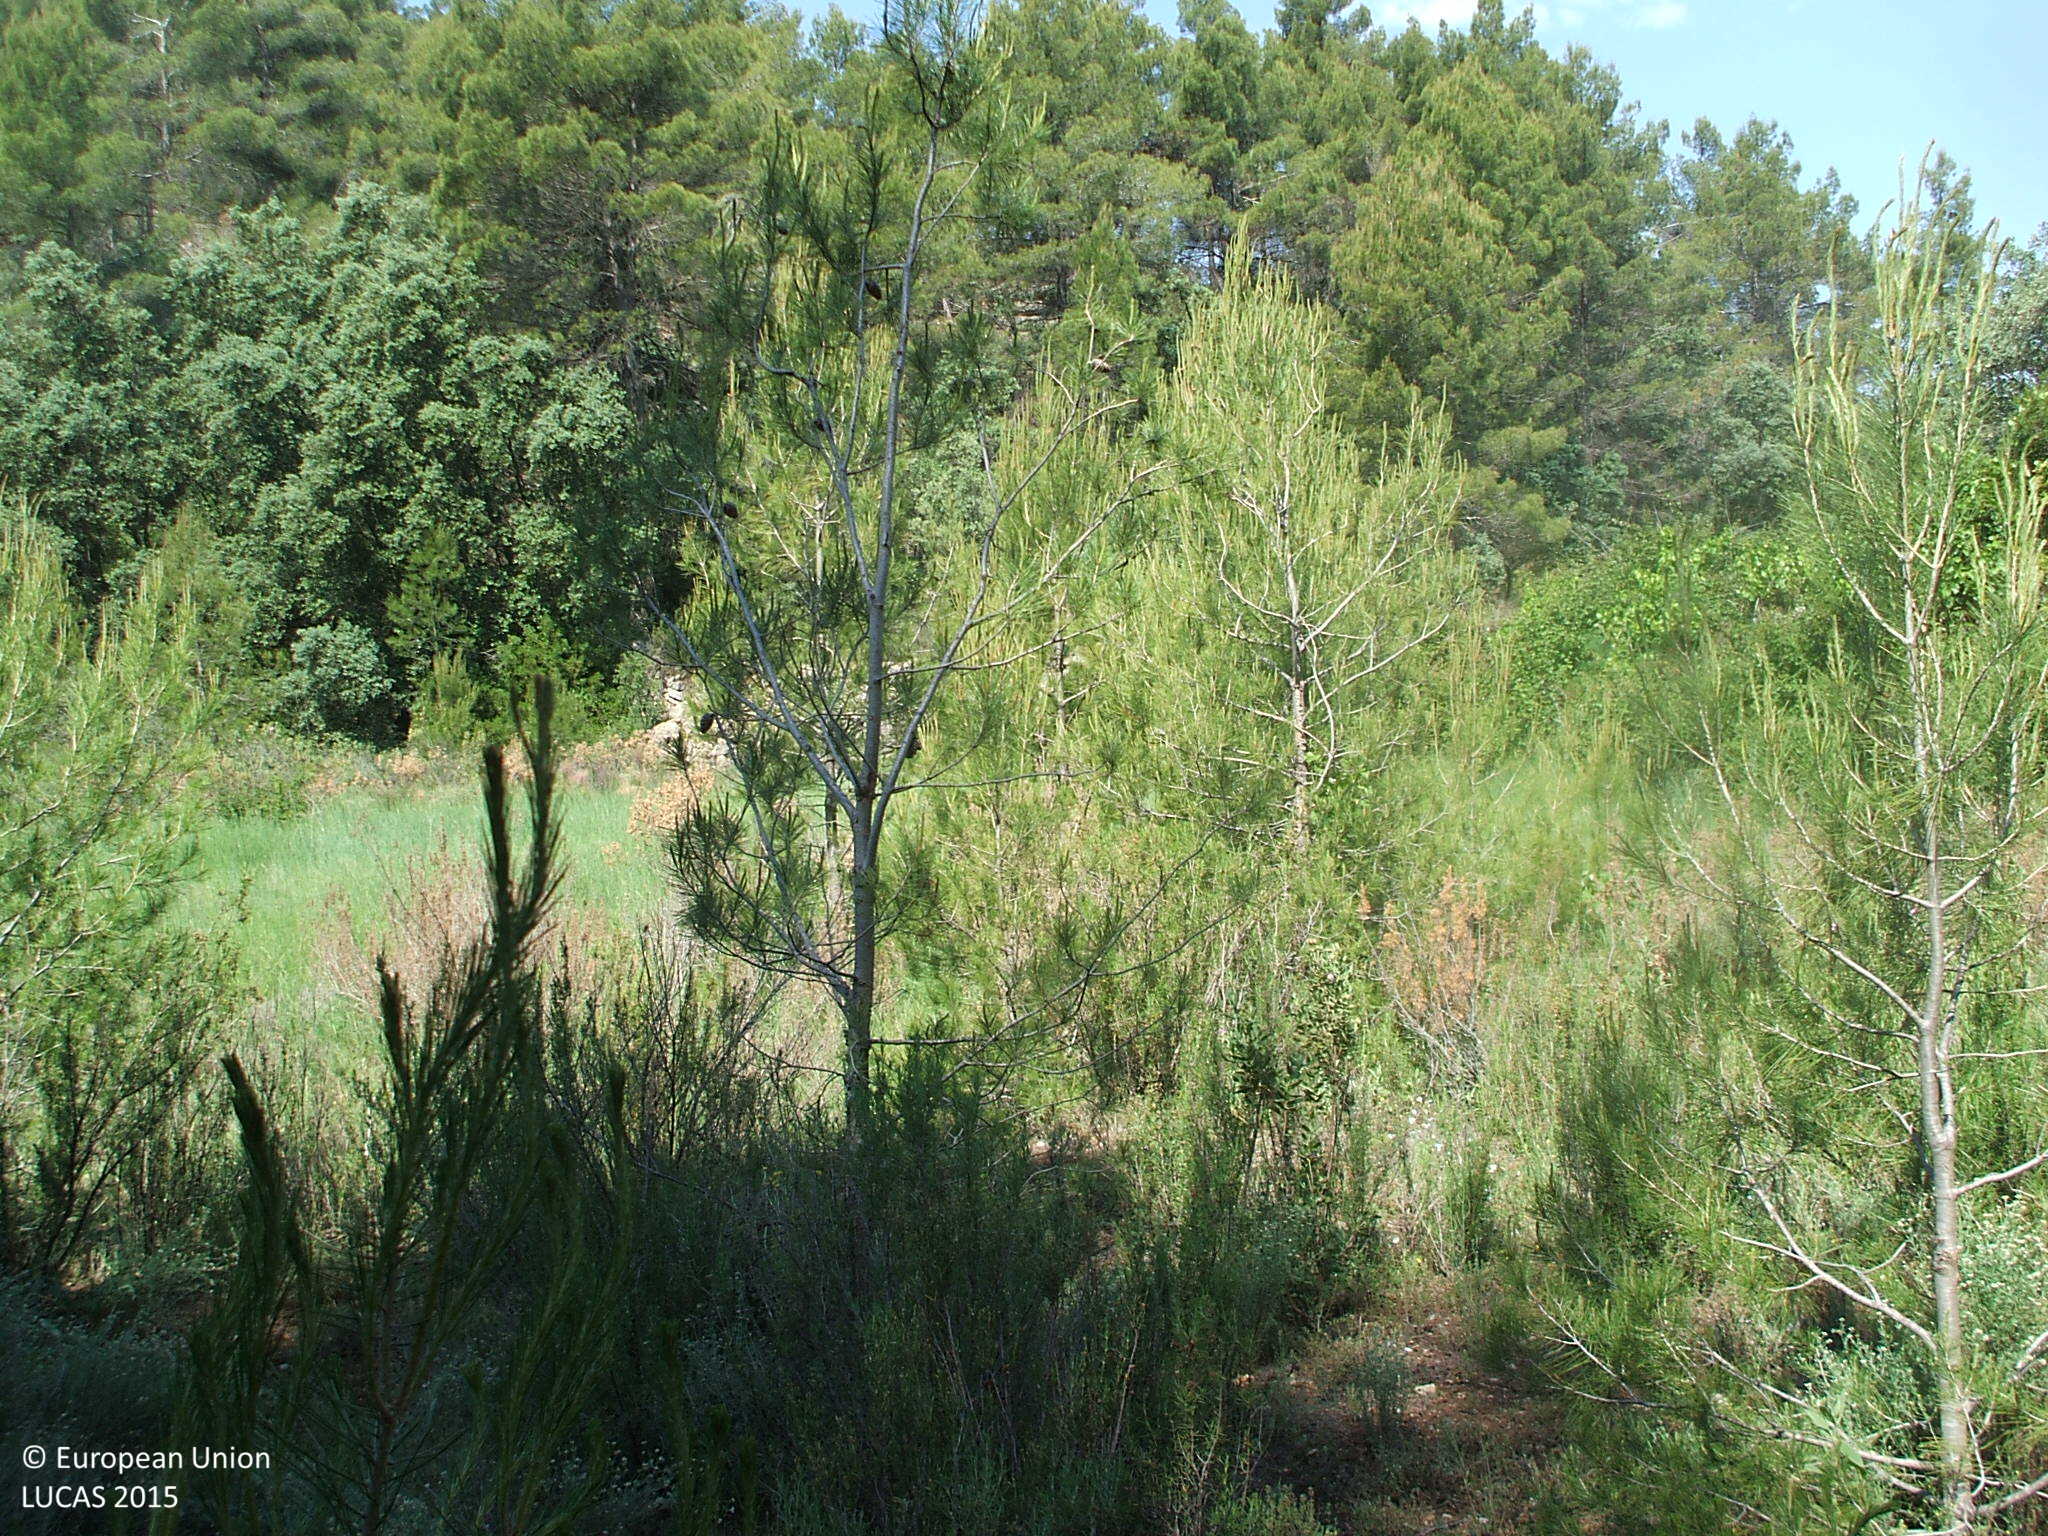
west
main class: Grassland
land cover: Grassland with sparse tree/shrub cover
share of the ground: > 75 %
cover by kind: herbaceous plants 95 %, coniferous forest trees 5 %
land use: Semi-natural and natural areas not in use
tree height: > 5 m
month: June
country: ES
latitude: 40.9009
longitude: -0.0164
